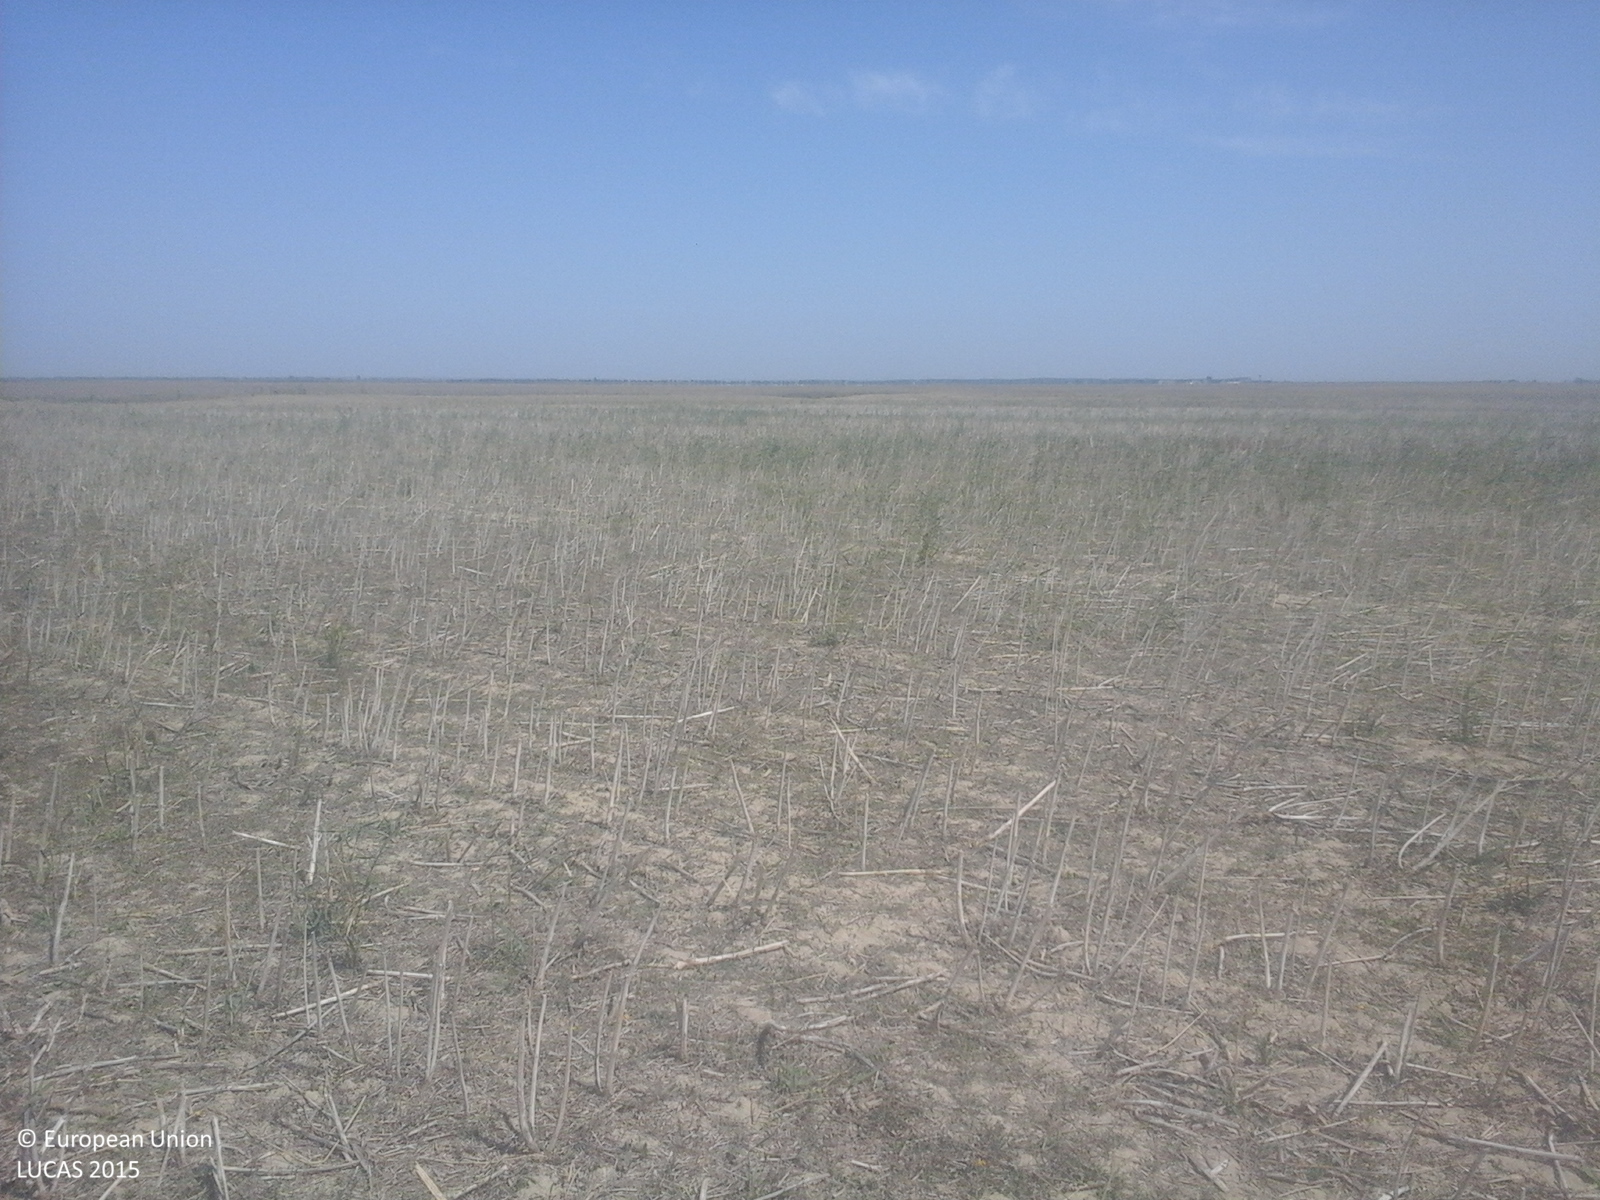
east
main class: Cropland
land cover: Rape and turnip rape
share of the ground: 25 - 50 %
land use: Agriculture (excluding fallow land and kitchen gardens)
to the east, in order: Rape and turnip rape; Grassland without tree/shrub cover; Ditches and canals; Grassland without tree/shrub cover
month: August
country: RO
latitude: 45.5325
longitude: 27.4256
